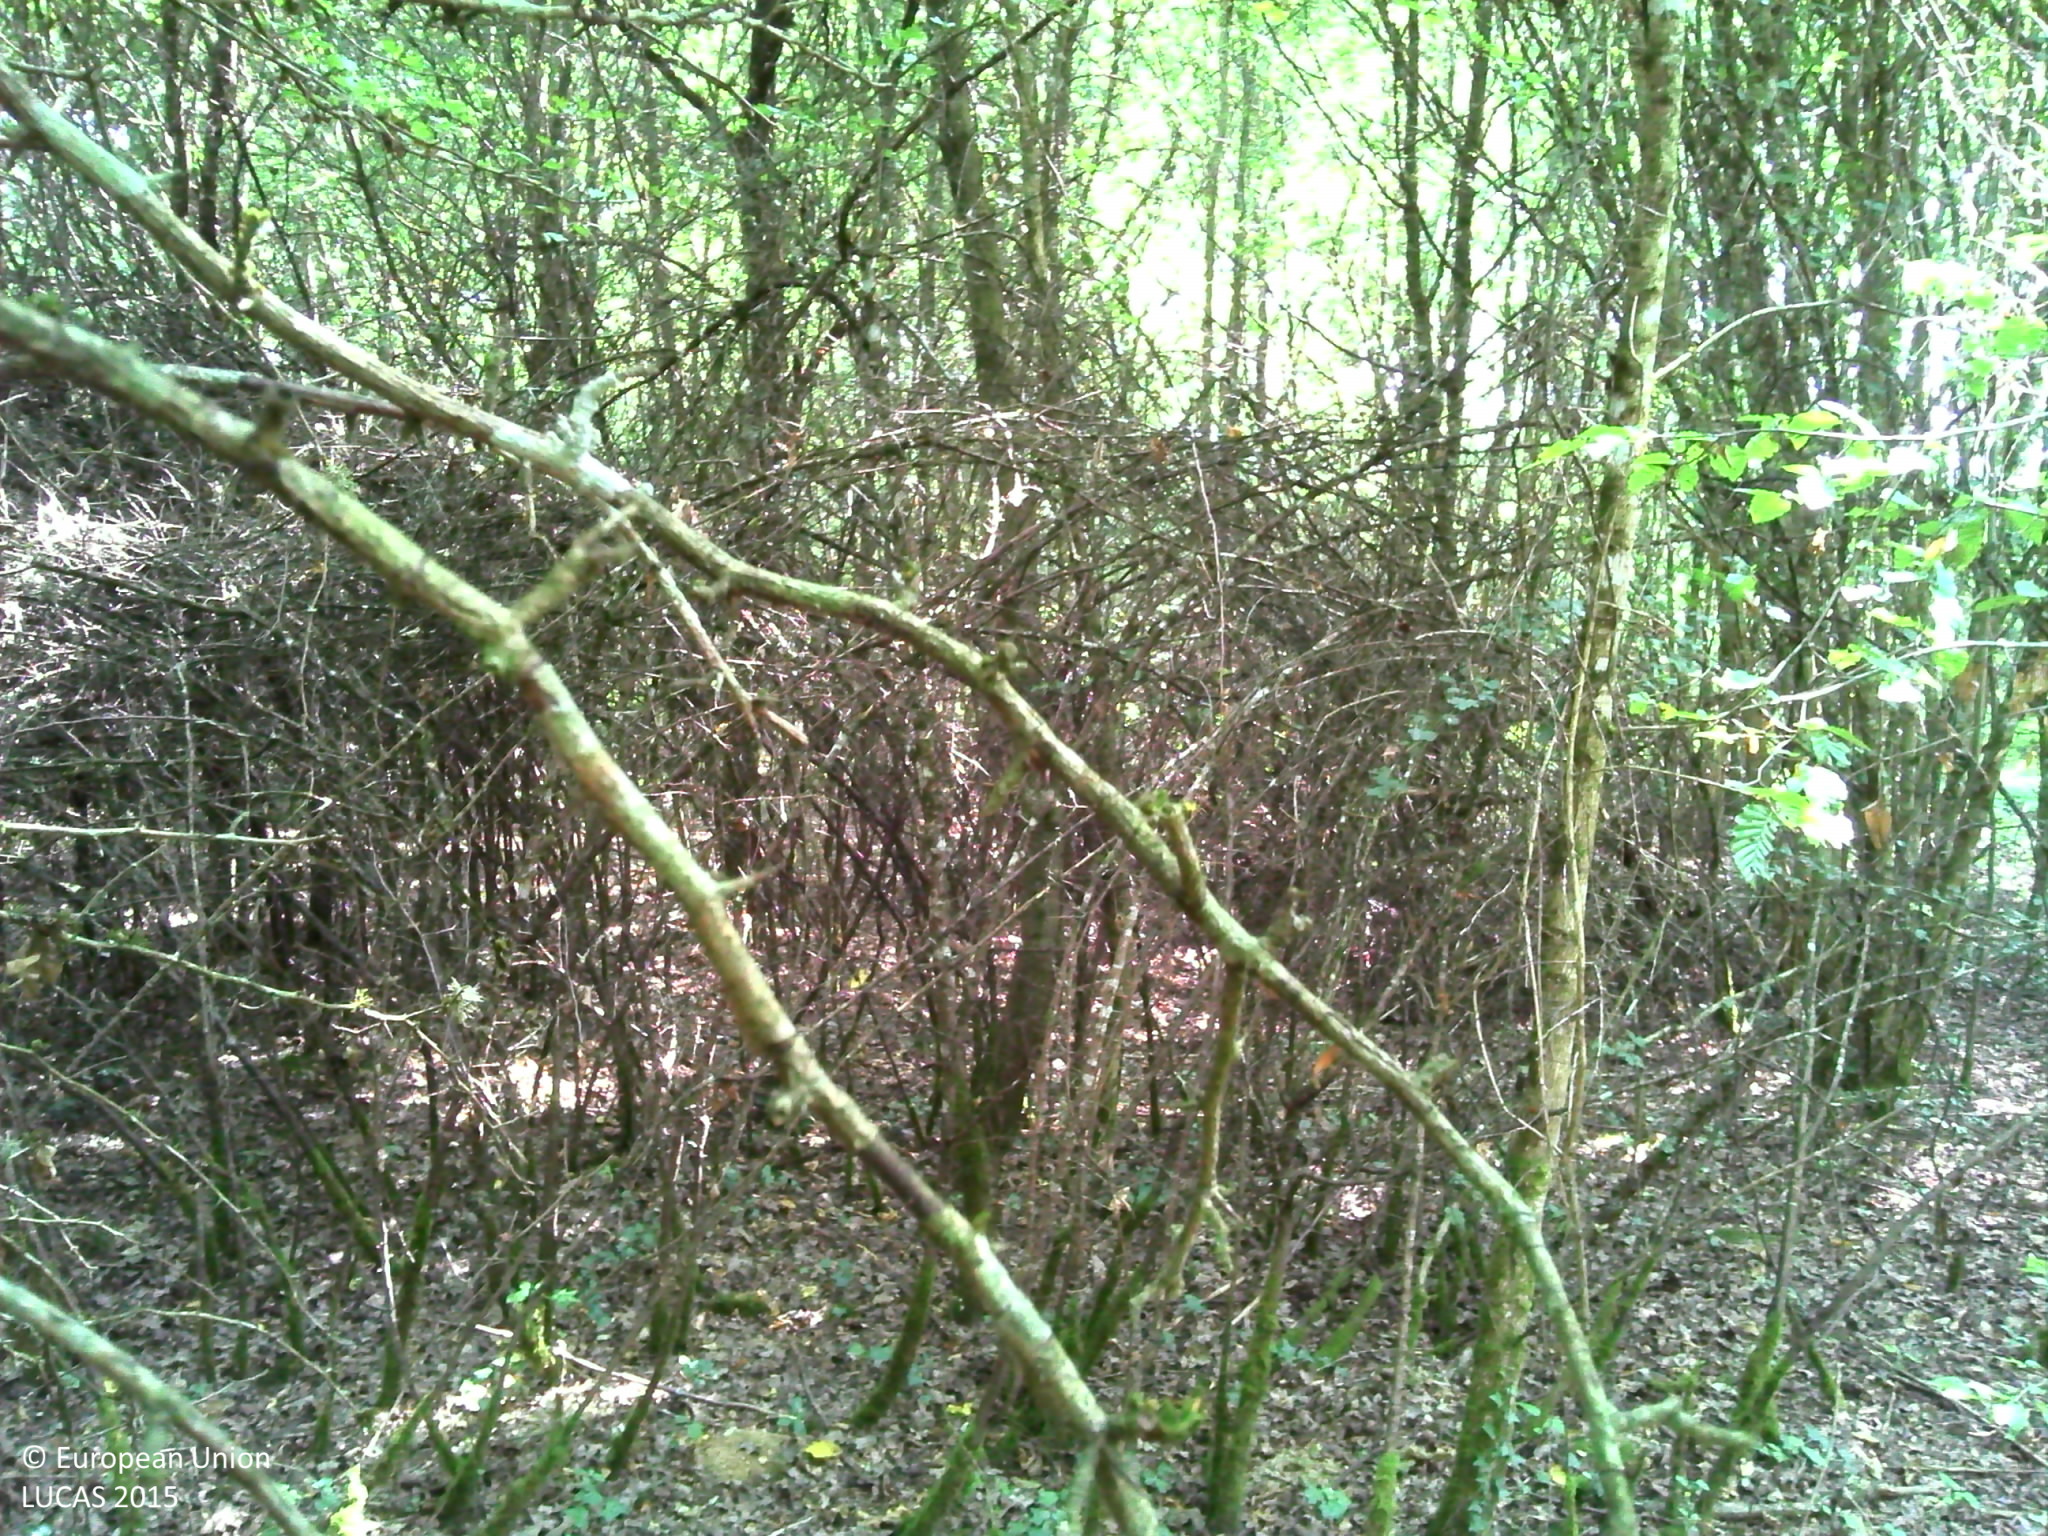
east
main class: Woodland
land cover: Broadleaved woodland
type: mesophytic deciduous forest
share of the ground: > 75 %
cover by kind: broadleaved forest trees 90 %, herbaceous plants 5 %, lichens and mosses 5 %
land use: Forestry
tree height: > 5 m
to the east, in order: Broadleaved woodland; Fences; Grassland without tree/shrub cover; Fences; Lines of trees; Fences; Grassland without tree/shrub cover; Fences; Abandoned hedges; Grassland without tree/shrub cover; Fences; Grassland without tree/shrub cover
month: August
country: FR
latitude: 47.7397
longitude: 3.1530
